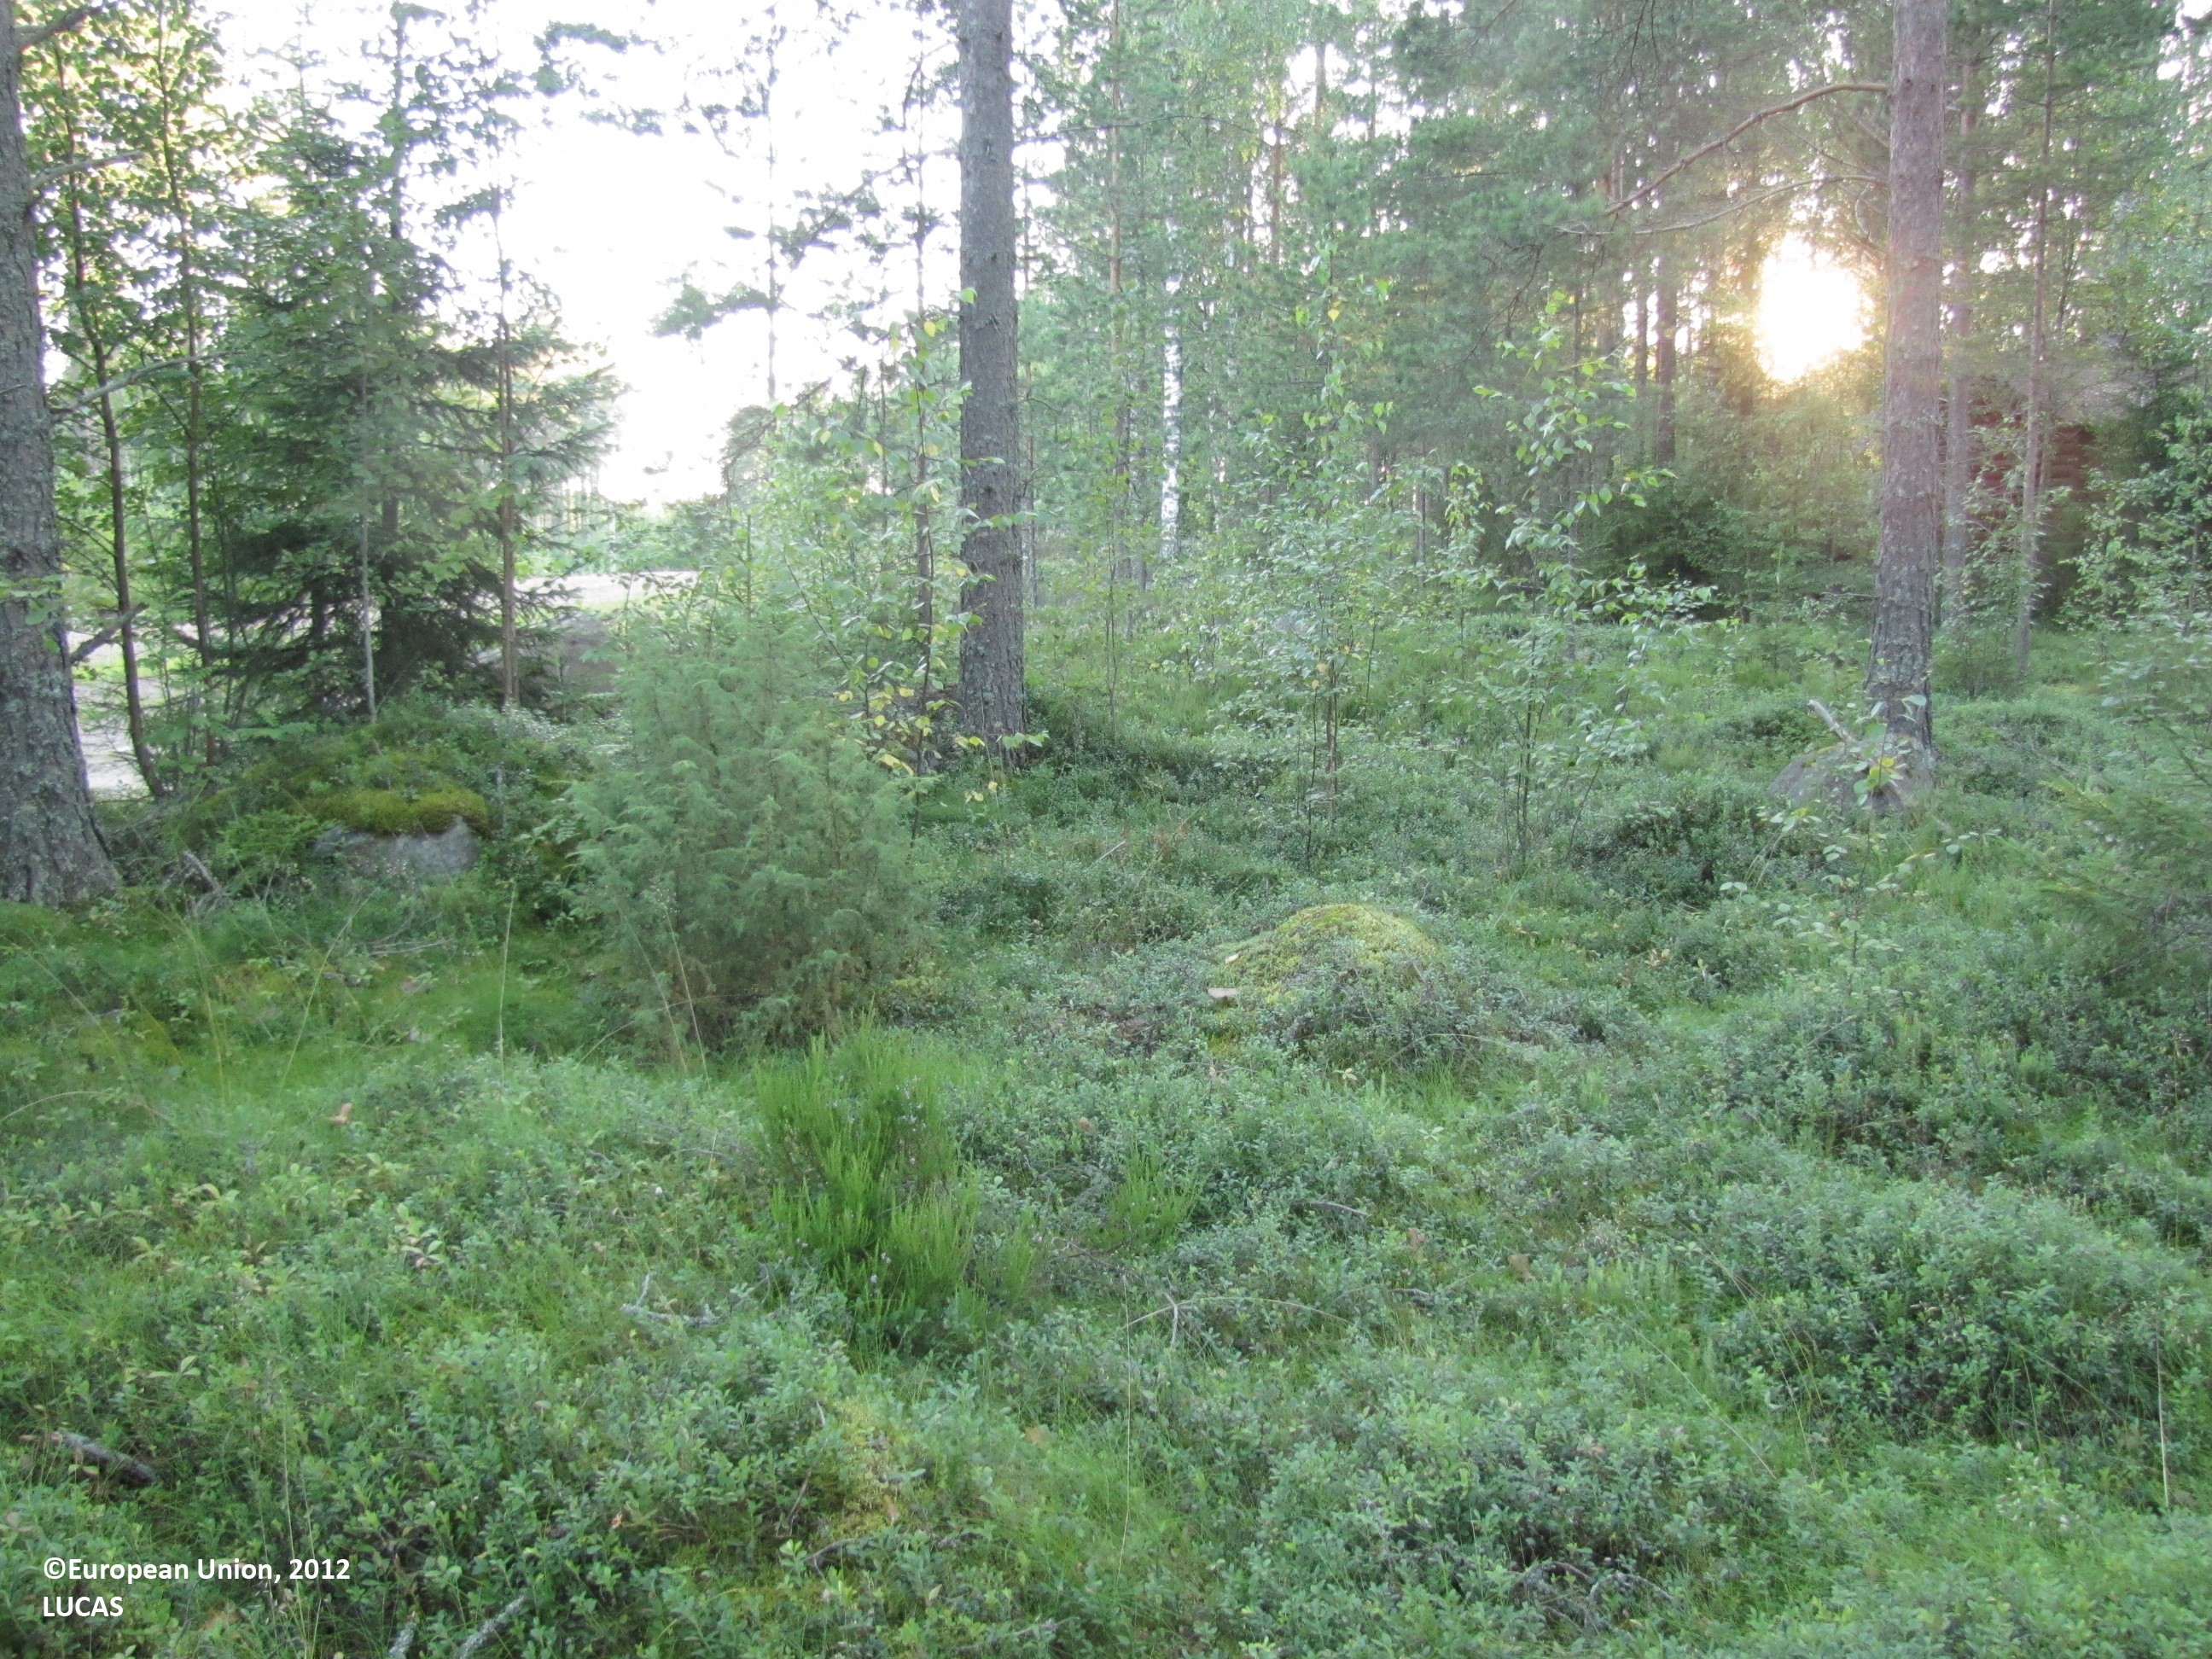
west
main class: Woodland
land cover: Pine dominated coniferous woodland
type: boreal forest
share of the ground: 50 - 75 %
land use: Forestry
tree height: > 5 m
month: July
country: FI
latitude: 62.0800
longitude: 23.0274
